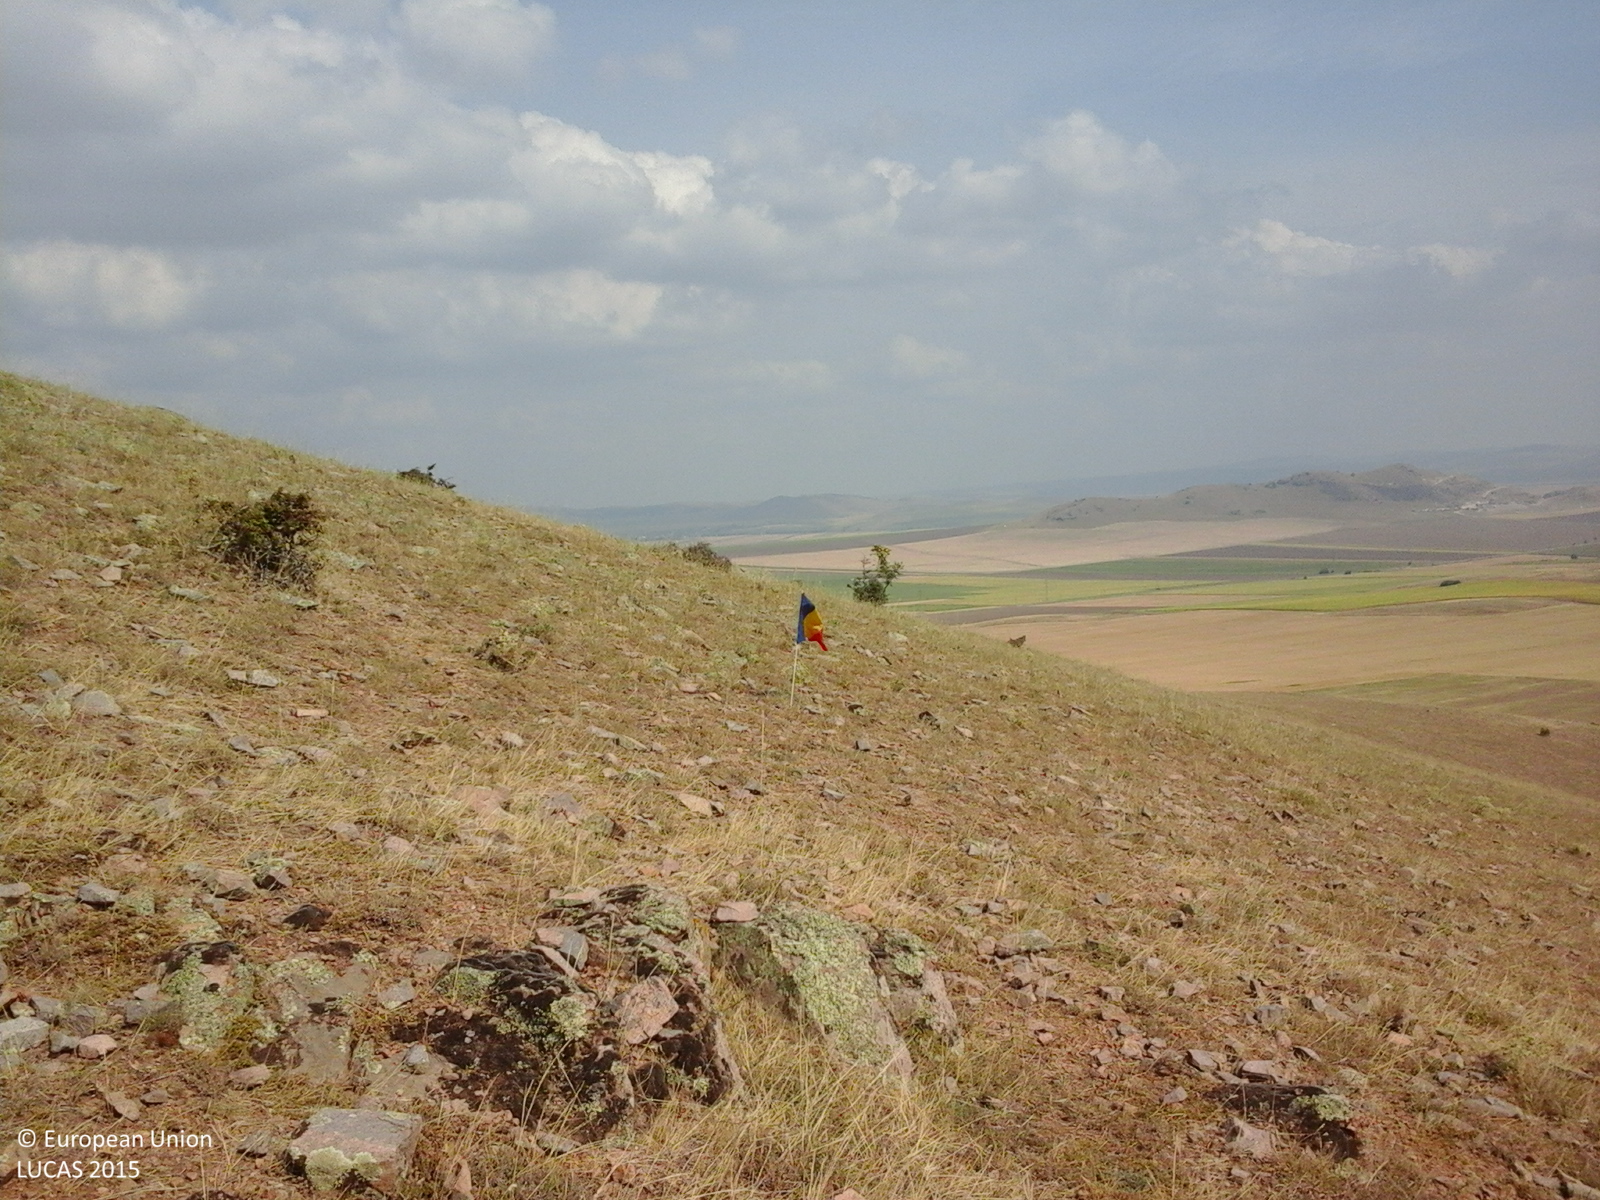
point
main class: Grassland
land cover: Grassland with sparse tree/shrub cover
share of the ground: > 75 %
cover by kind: herbaceous plants 90 %, broadleaved forest trees 5 %, shrubs 5 %
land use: Agriculture (excluding fallow land and kitchen gardens)
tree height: < 5 m
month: July
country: RO
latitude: 45.1037
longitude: 28.2050
